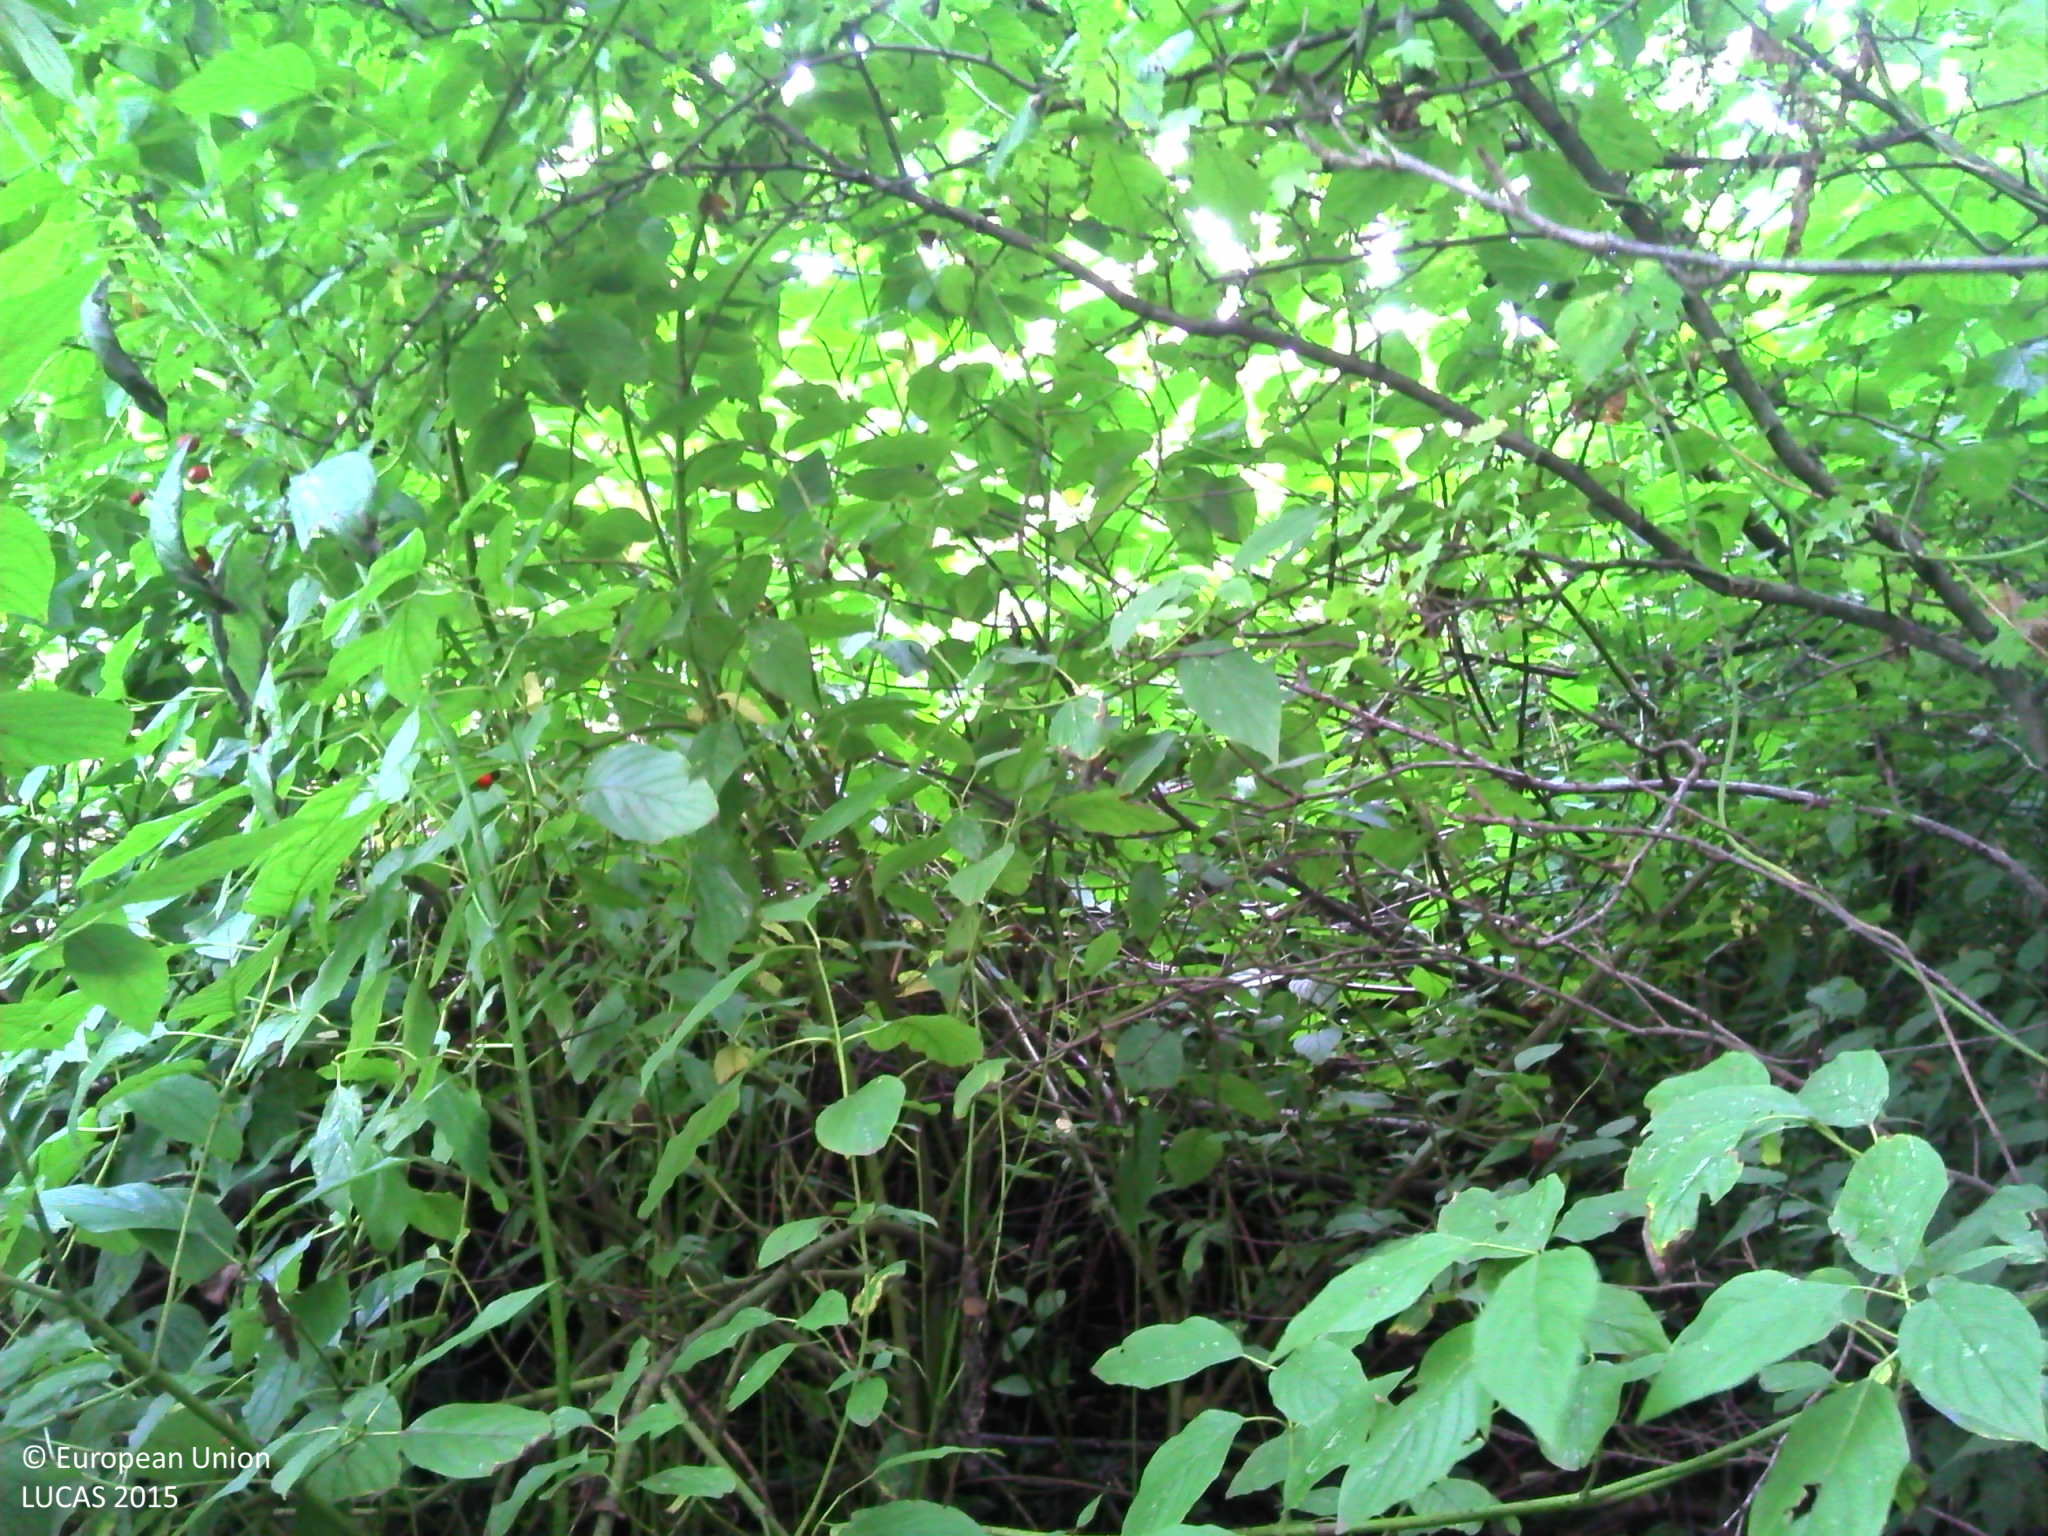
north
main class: Woodland
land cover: Broadleaved woodland
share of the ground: > 75 %
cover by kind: broadleaved forest trees 65 %, shrubs 15 %, coniferous forest trees 10 %, herbaceous plants 10 %
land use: Semi-natural and natural areas not in use
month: September
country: BE
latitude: 51.1616
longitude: 4.3470
